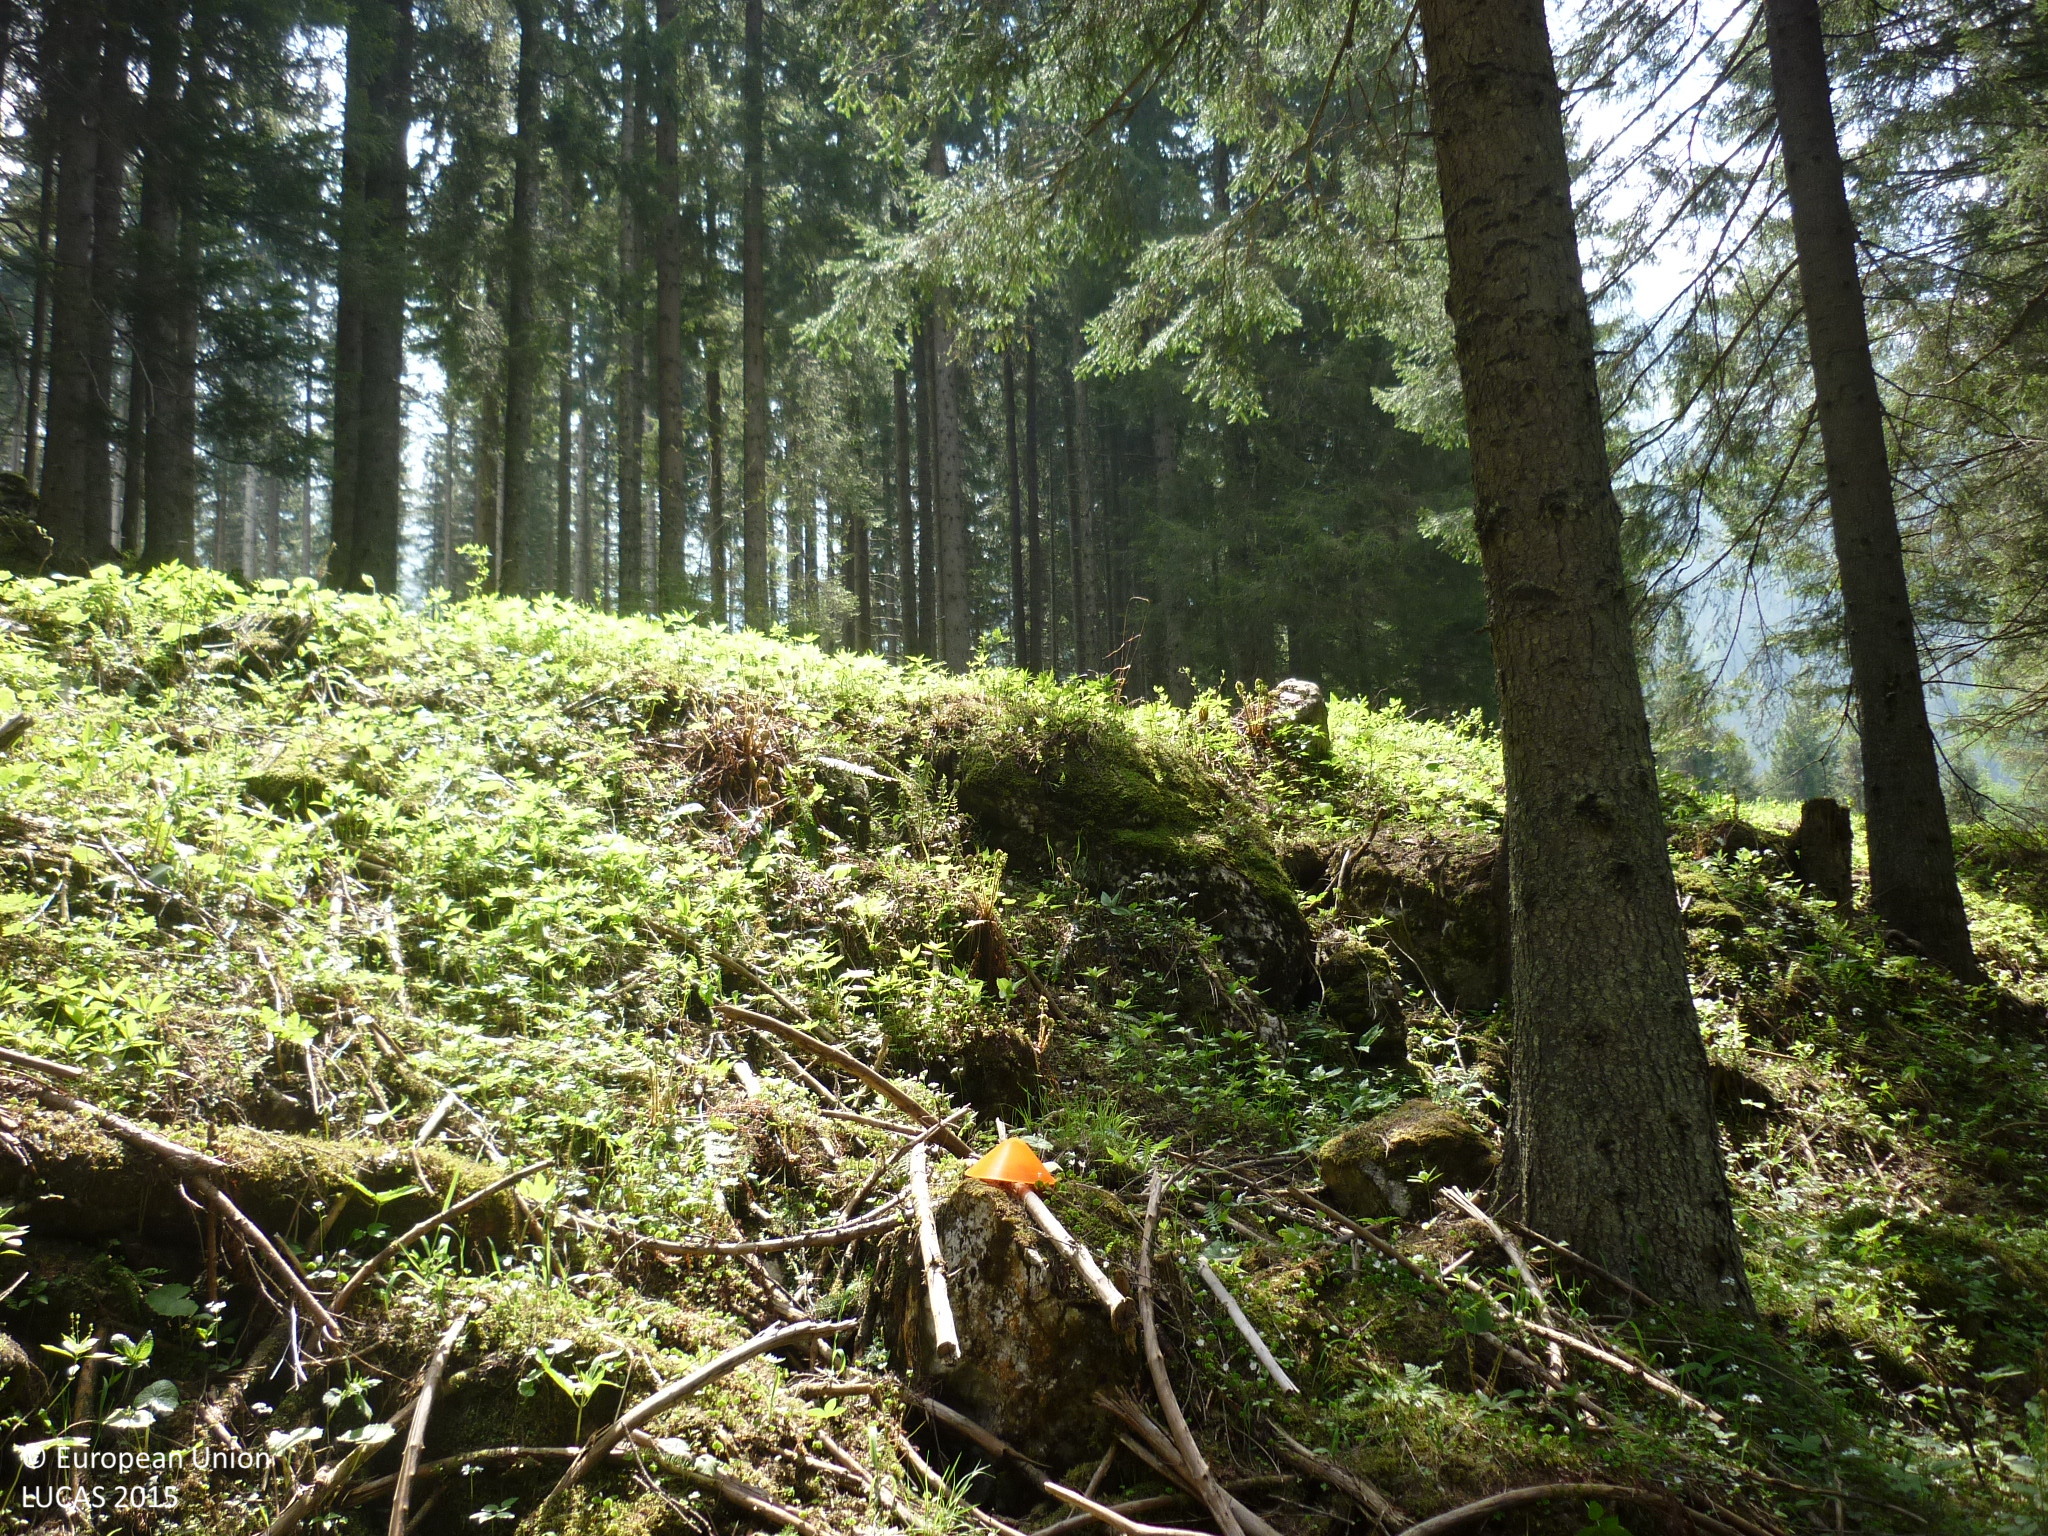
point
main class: Woodland
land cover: Spruce dominated coniferous woodland
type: alpine coniferous forest
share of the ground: > 75 %
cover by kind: coniferous forest trees 85 %, herbaceous plants 15 %
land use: Forestry
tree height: > 5 m
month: May
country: AT
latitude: 47.5532
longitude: 14.9566
